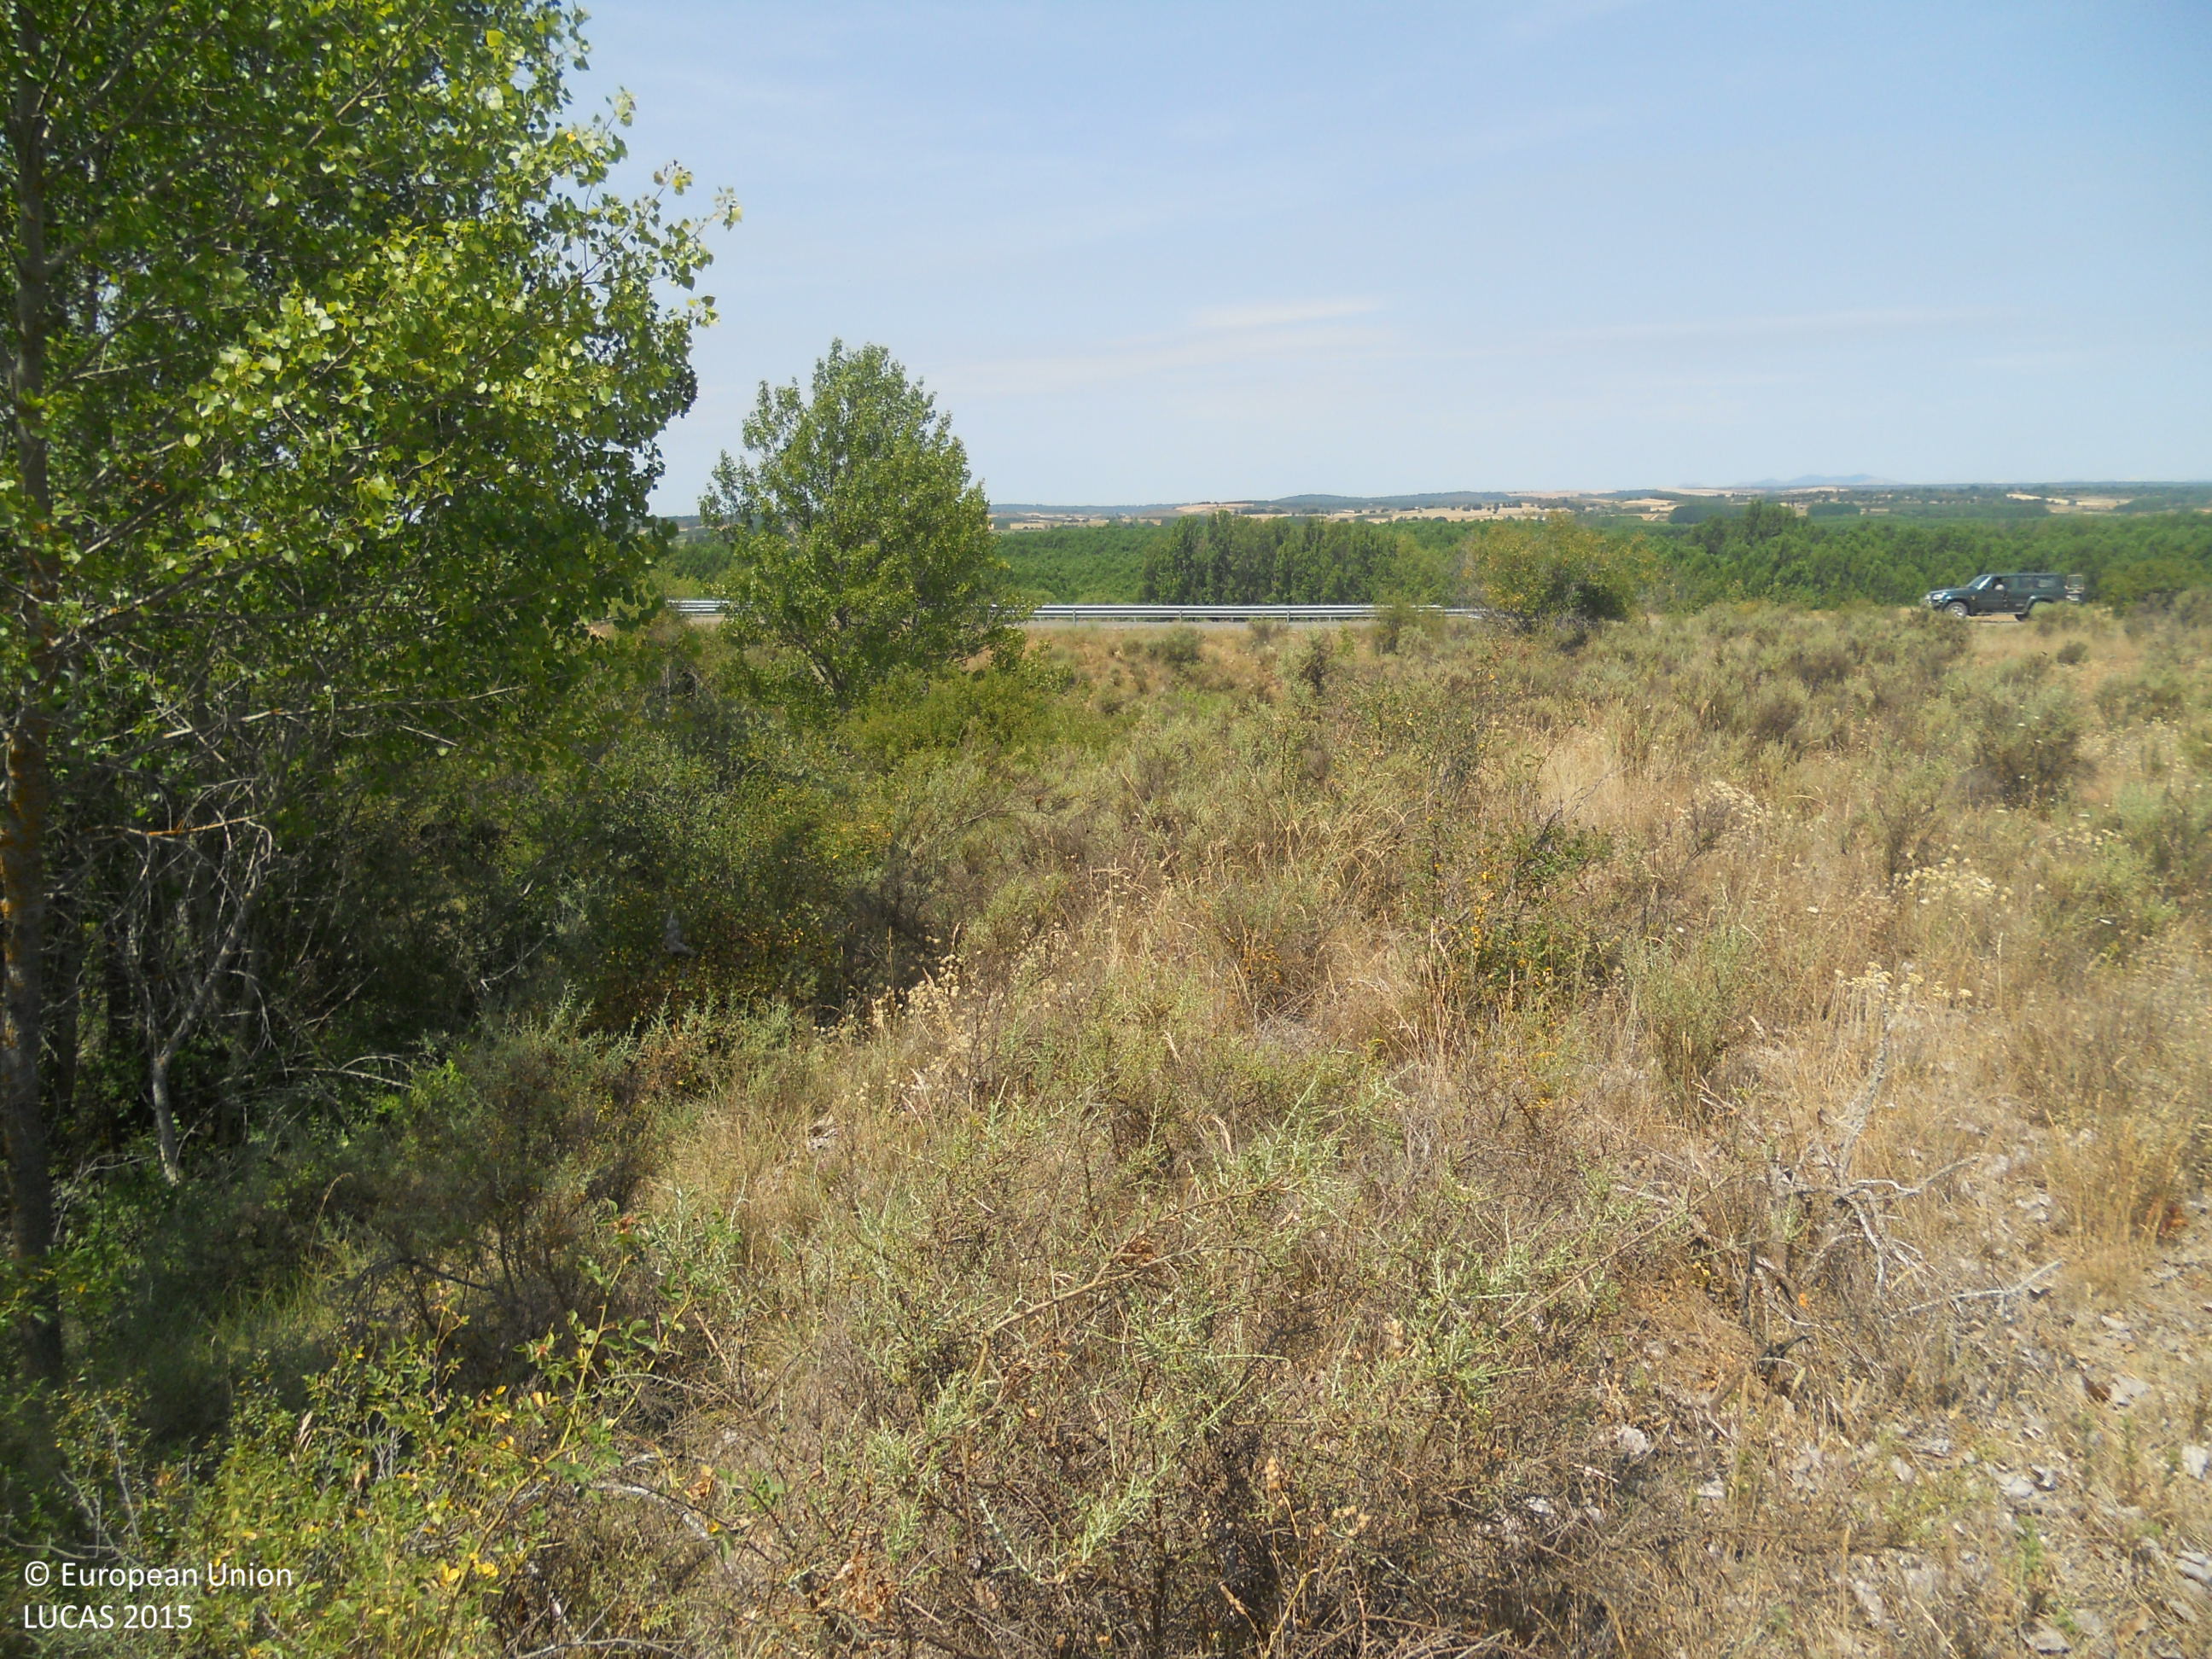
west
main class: Shrubland
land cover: Shrubland without tree cover
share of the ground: > 75 %
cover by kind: shrubs 60 %, herbaceous plants 40 %
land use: Semi-natural and natural areas not in use
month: July
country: ES
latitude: 42.6284
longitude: -5.3719
